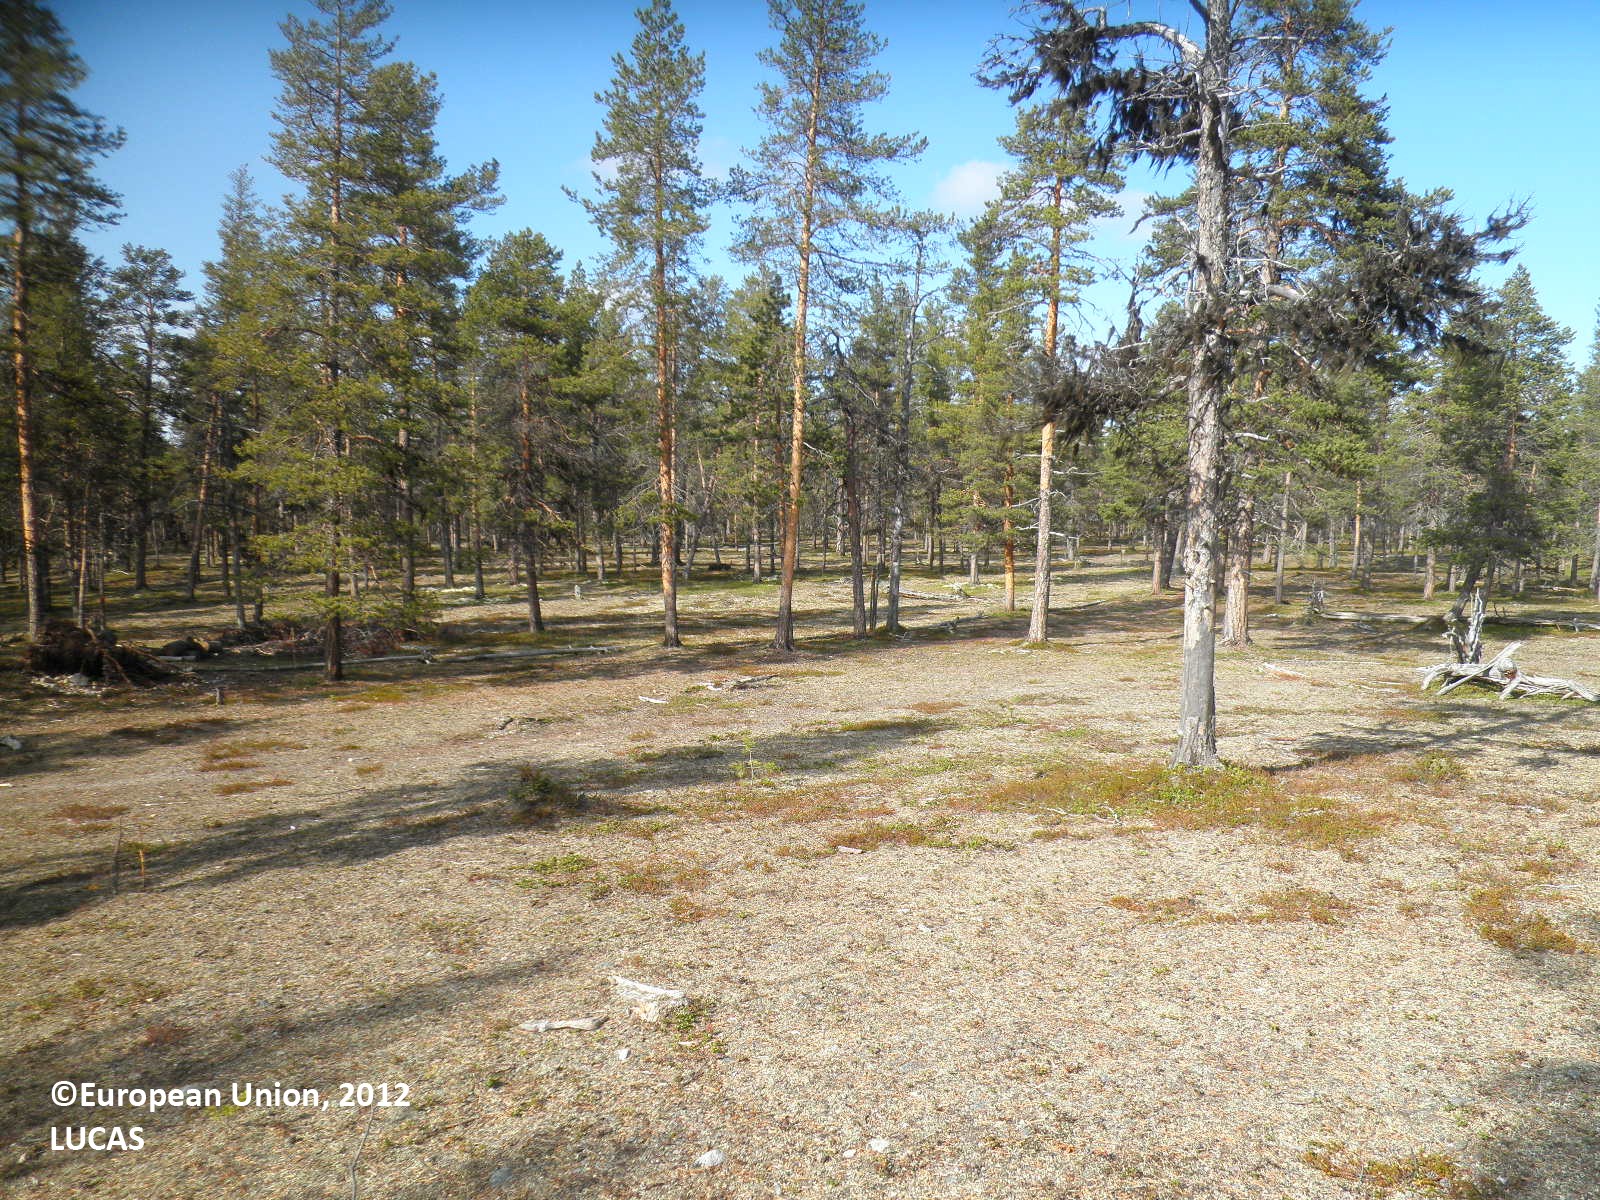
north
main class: Woodland
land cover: Pine dominated coniferous woodland
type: boreal forest
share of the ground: 10 - 25 %
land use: Forestry
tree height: > 5 m
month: June
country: FI
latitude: 68.9009
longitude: 26.0936
